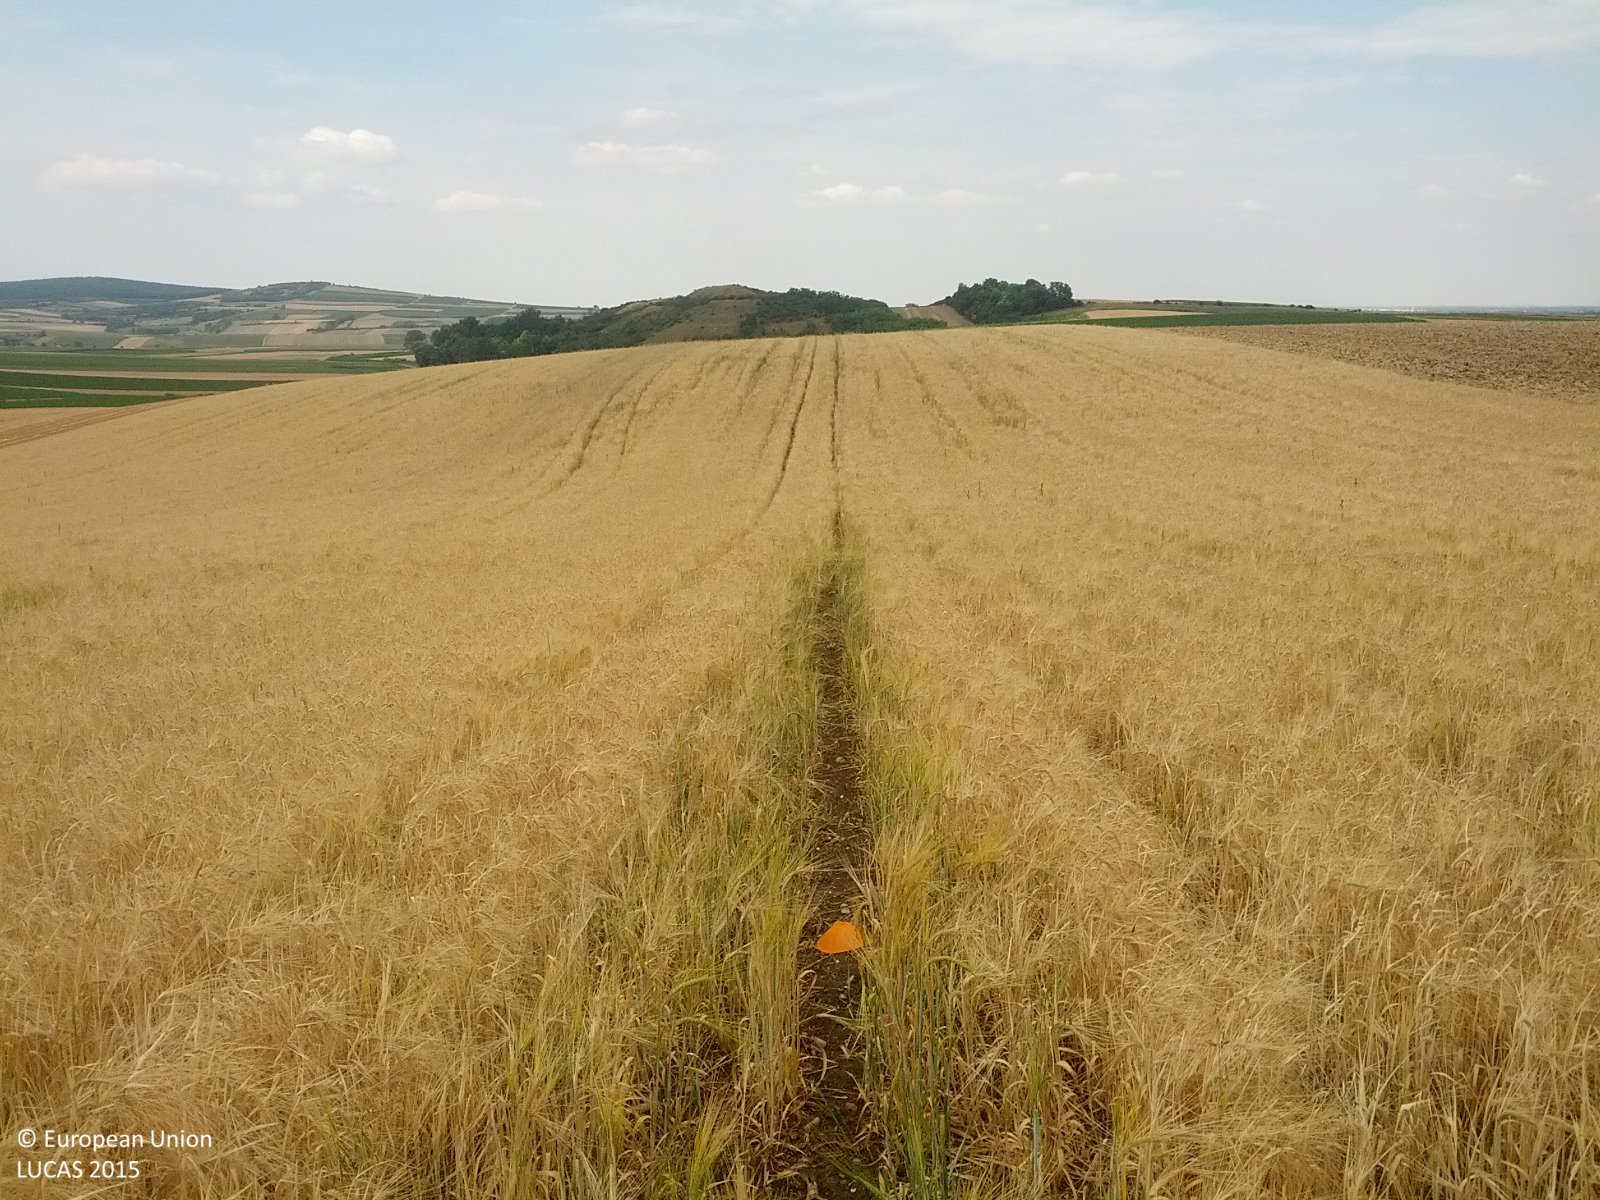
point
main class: Cropland
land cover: Barley
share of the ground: > 75 %
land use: Agriculture (excluding fallow land and kitchen gardens)
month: July
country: AT
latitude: 48.6098
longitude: 16.1762
